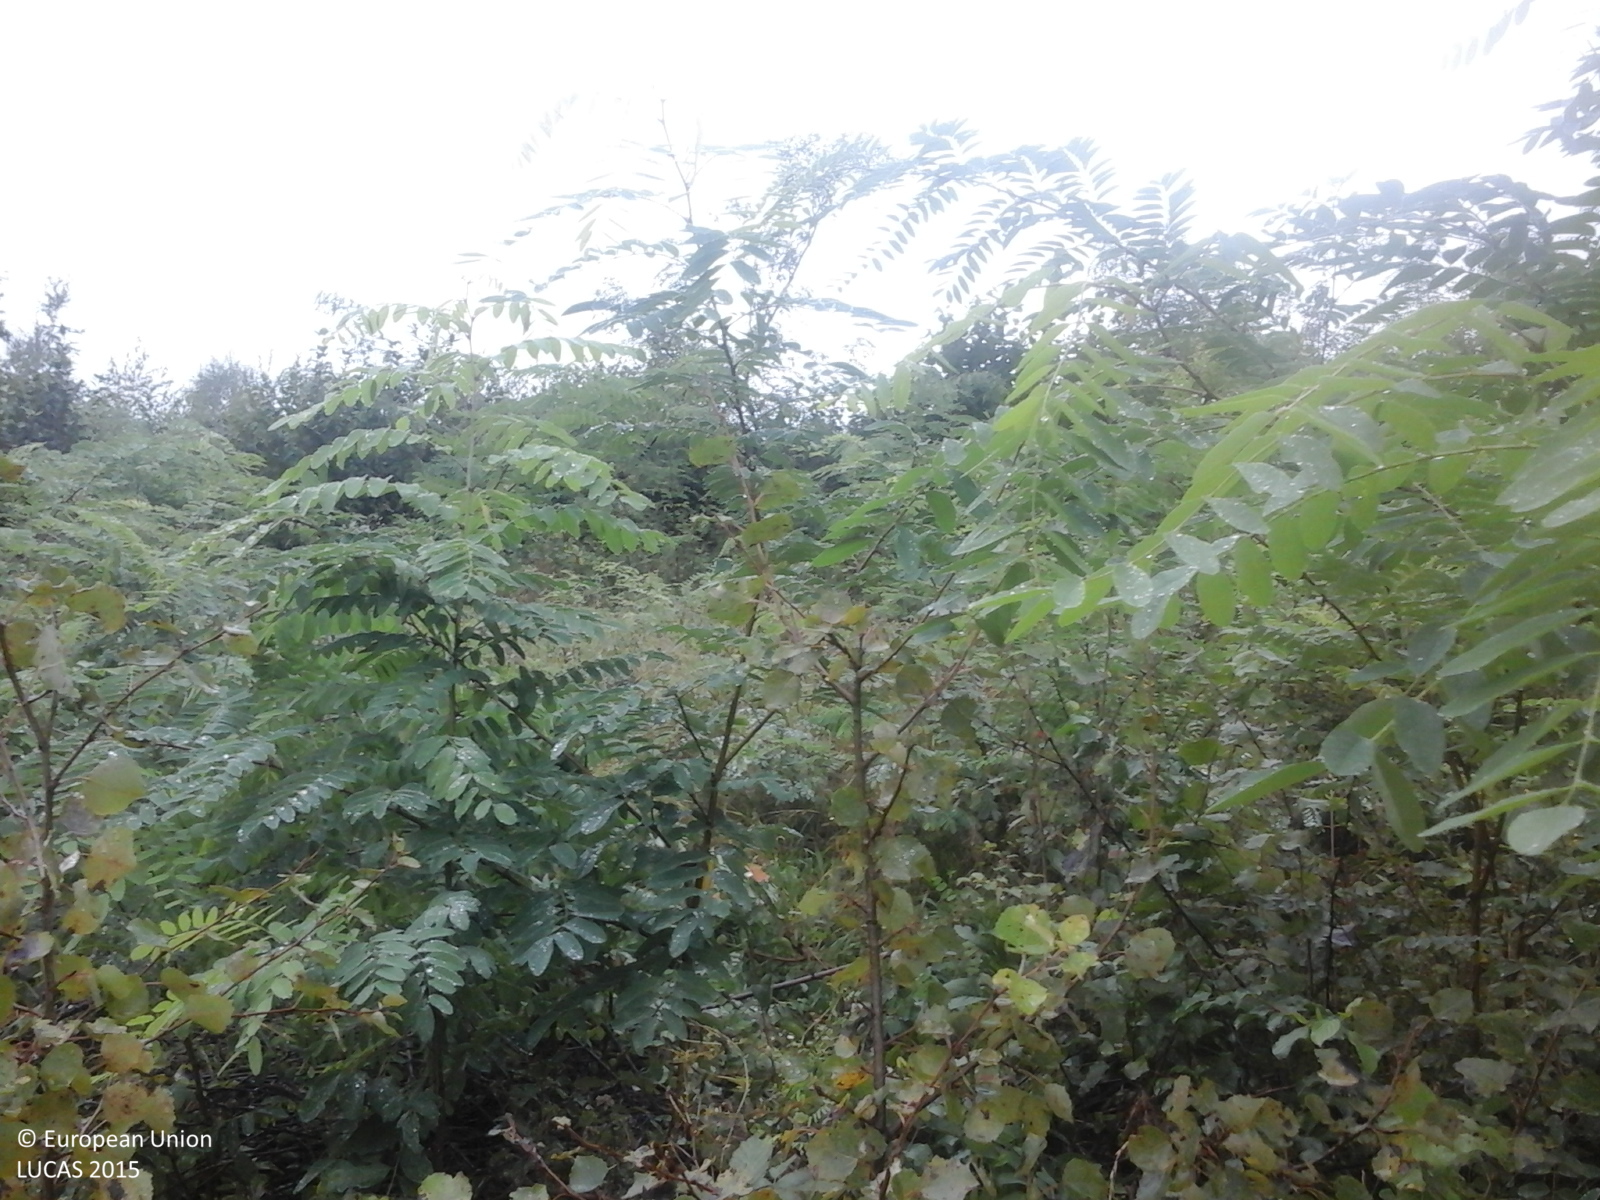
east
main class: Woodland
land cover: Broadleaved woodland
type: mesophytic deciduous forest
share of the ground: > 75 %
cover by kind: broadleaved forest trees 75 %, shrubs 25 %
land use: Semi-natural and natural areas not in use
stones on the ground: < 10 %
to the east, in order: Shrubland without tree cover; Fences; Broadleaved woodland; Spontaneously vegetated surfaces; Broadleaved woodland; Grassland without tree/shrub cover; Lines of trees; Grassland with sparse tree/shrub cover; Spruce dominated coniferous woodland
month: September
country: RO
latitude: 47.0511
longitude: 22.5209
